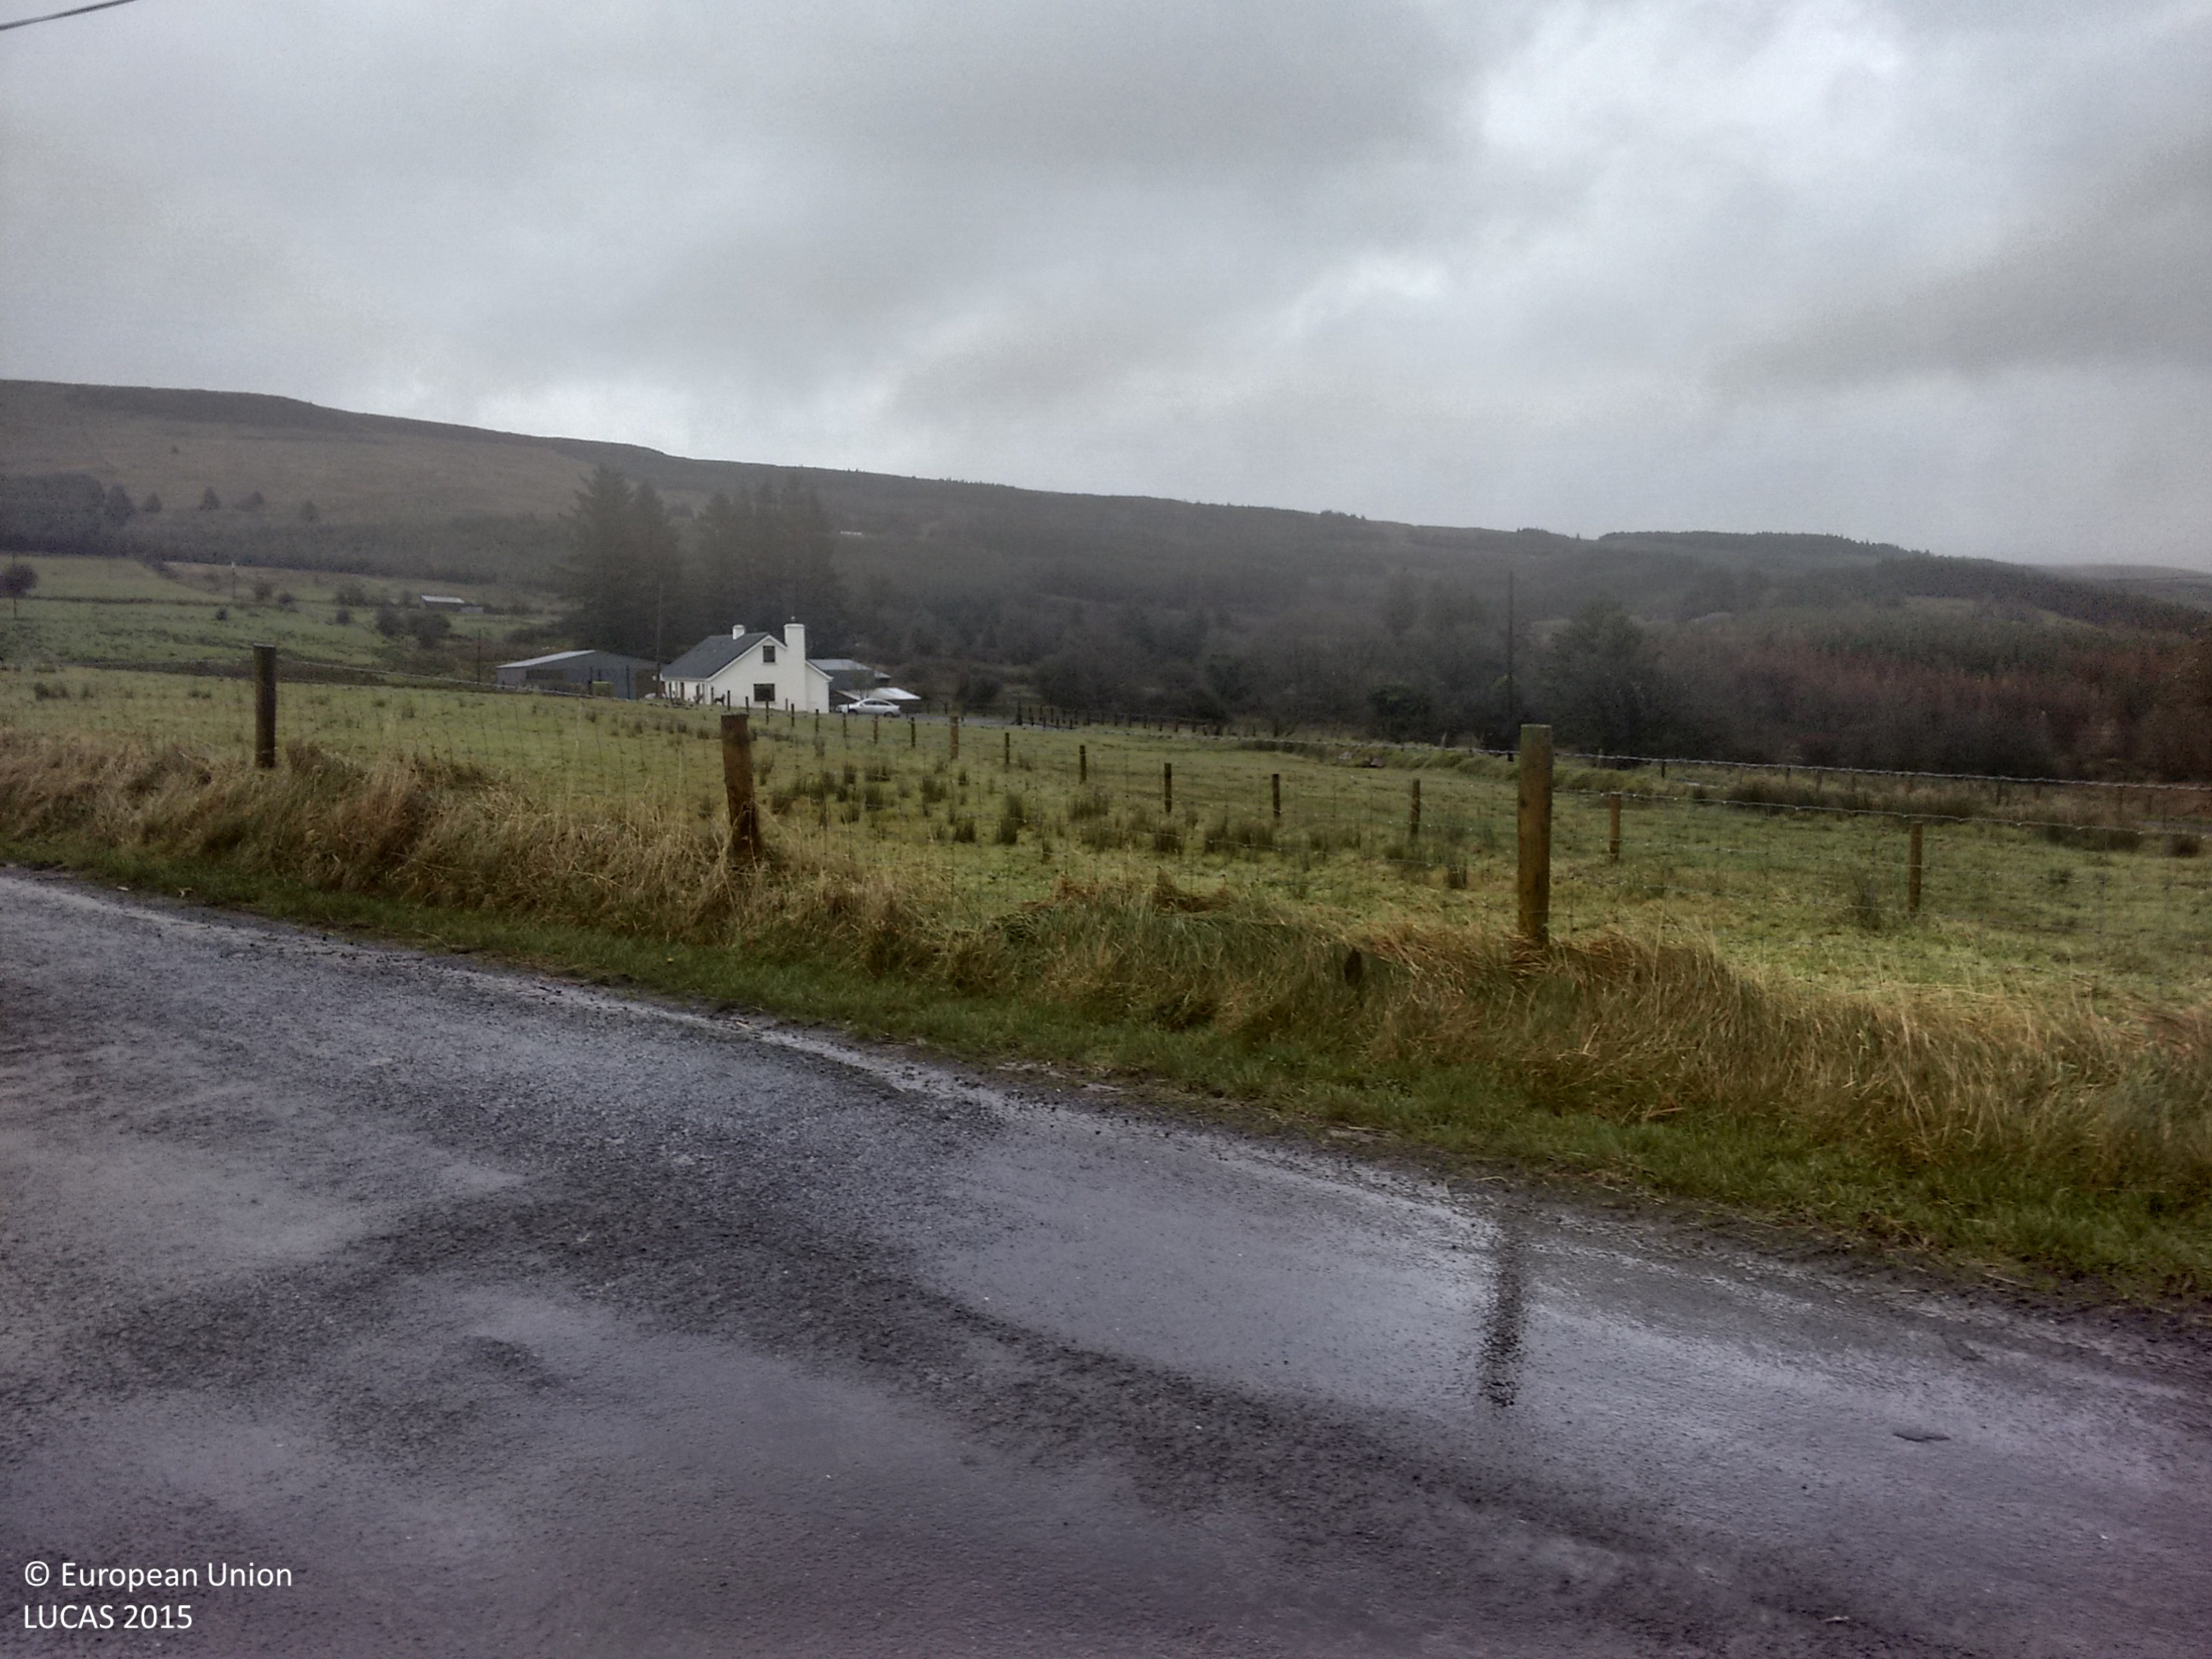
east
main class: Grassland
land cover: Grassland without tree/shrub cover
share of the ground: > 75 %
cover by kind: herbaceous plants 100 %
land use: Agriculture (excluding fallow land and kitchen gardens)
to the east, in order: Grassland without tree/shrub cover; Fences; Grass margins; Paved roads, cycling and walking lanes; Grass margins; Electric lines; Fences; Grassland without tree/shrub cover; Fences; Grassland without tree/shrub cover; Artificial constructions in urban areas; Abandoned hedges; Ditches and canals; Grassland without tree/shrub cover; Fences; Grass margins; Tracks; Grass margins; Fences; Grassland without tree/shrub cover
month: November
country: IE
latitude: 54.1212
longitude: -8.2525
